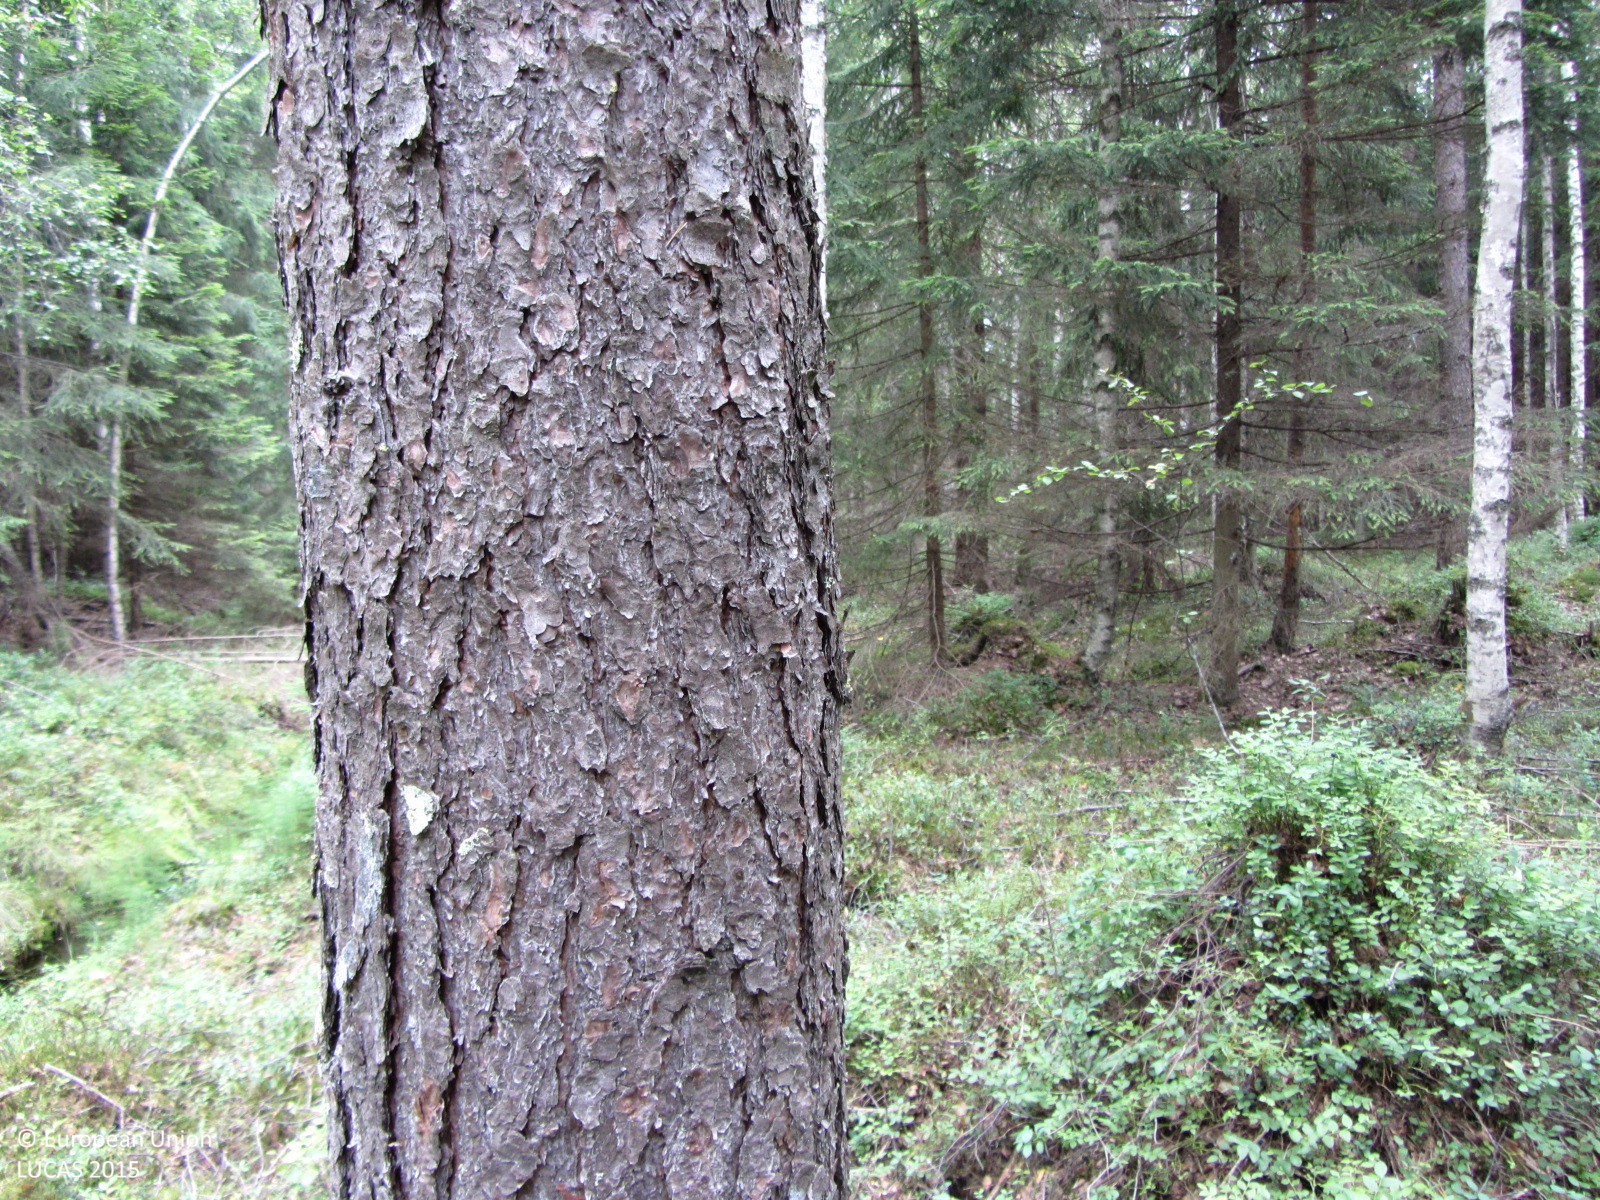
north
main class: Woodland
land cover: Other mixed woodland
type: boreal forest
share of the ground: > 75 %
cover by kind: coniferous forest trees 45 %, broadleaved forest trees 40 %, shrubs 15 %
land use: Forestry
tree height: > 5 m
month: July
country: FI
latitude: 60.5469
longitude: 24.3045
